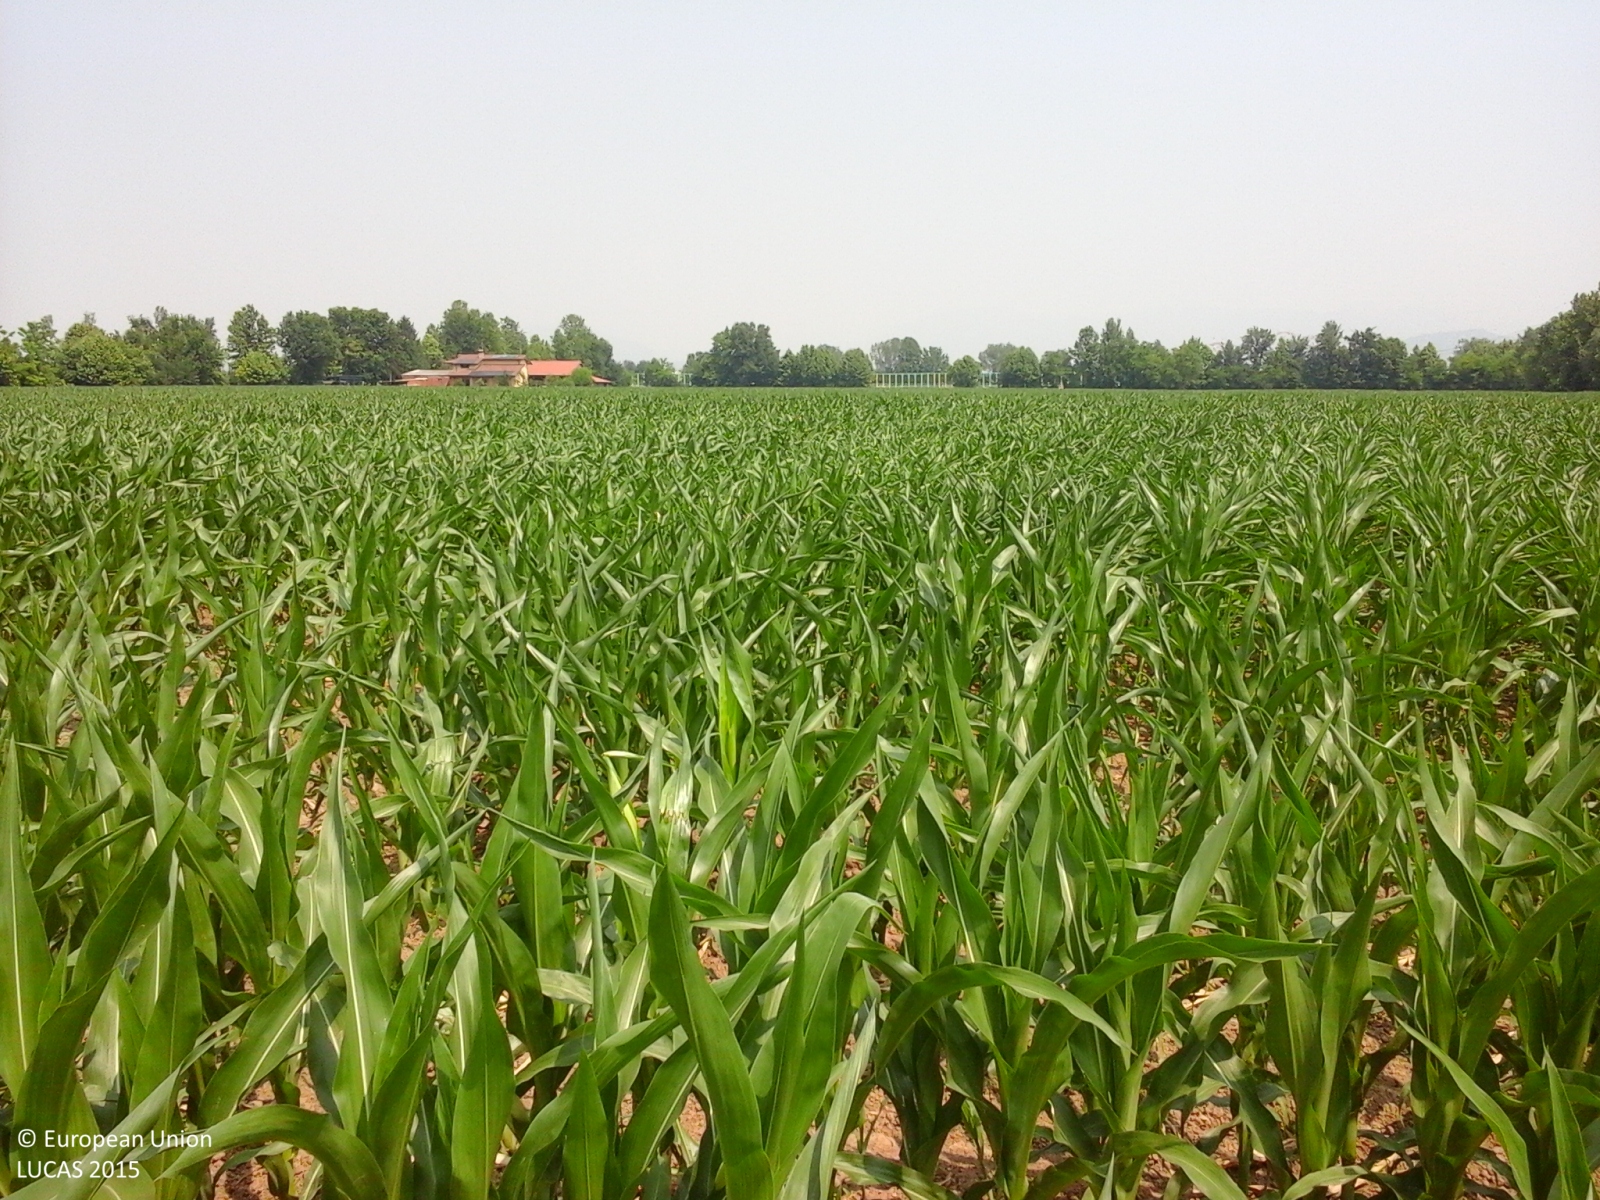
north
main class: Cropland
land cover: Maize
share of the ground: > 75 %
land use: Agriculture (excluding fallow land and kitchen gardens)
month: June
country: IT
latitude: 45.4682
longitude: 10.1915
